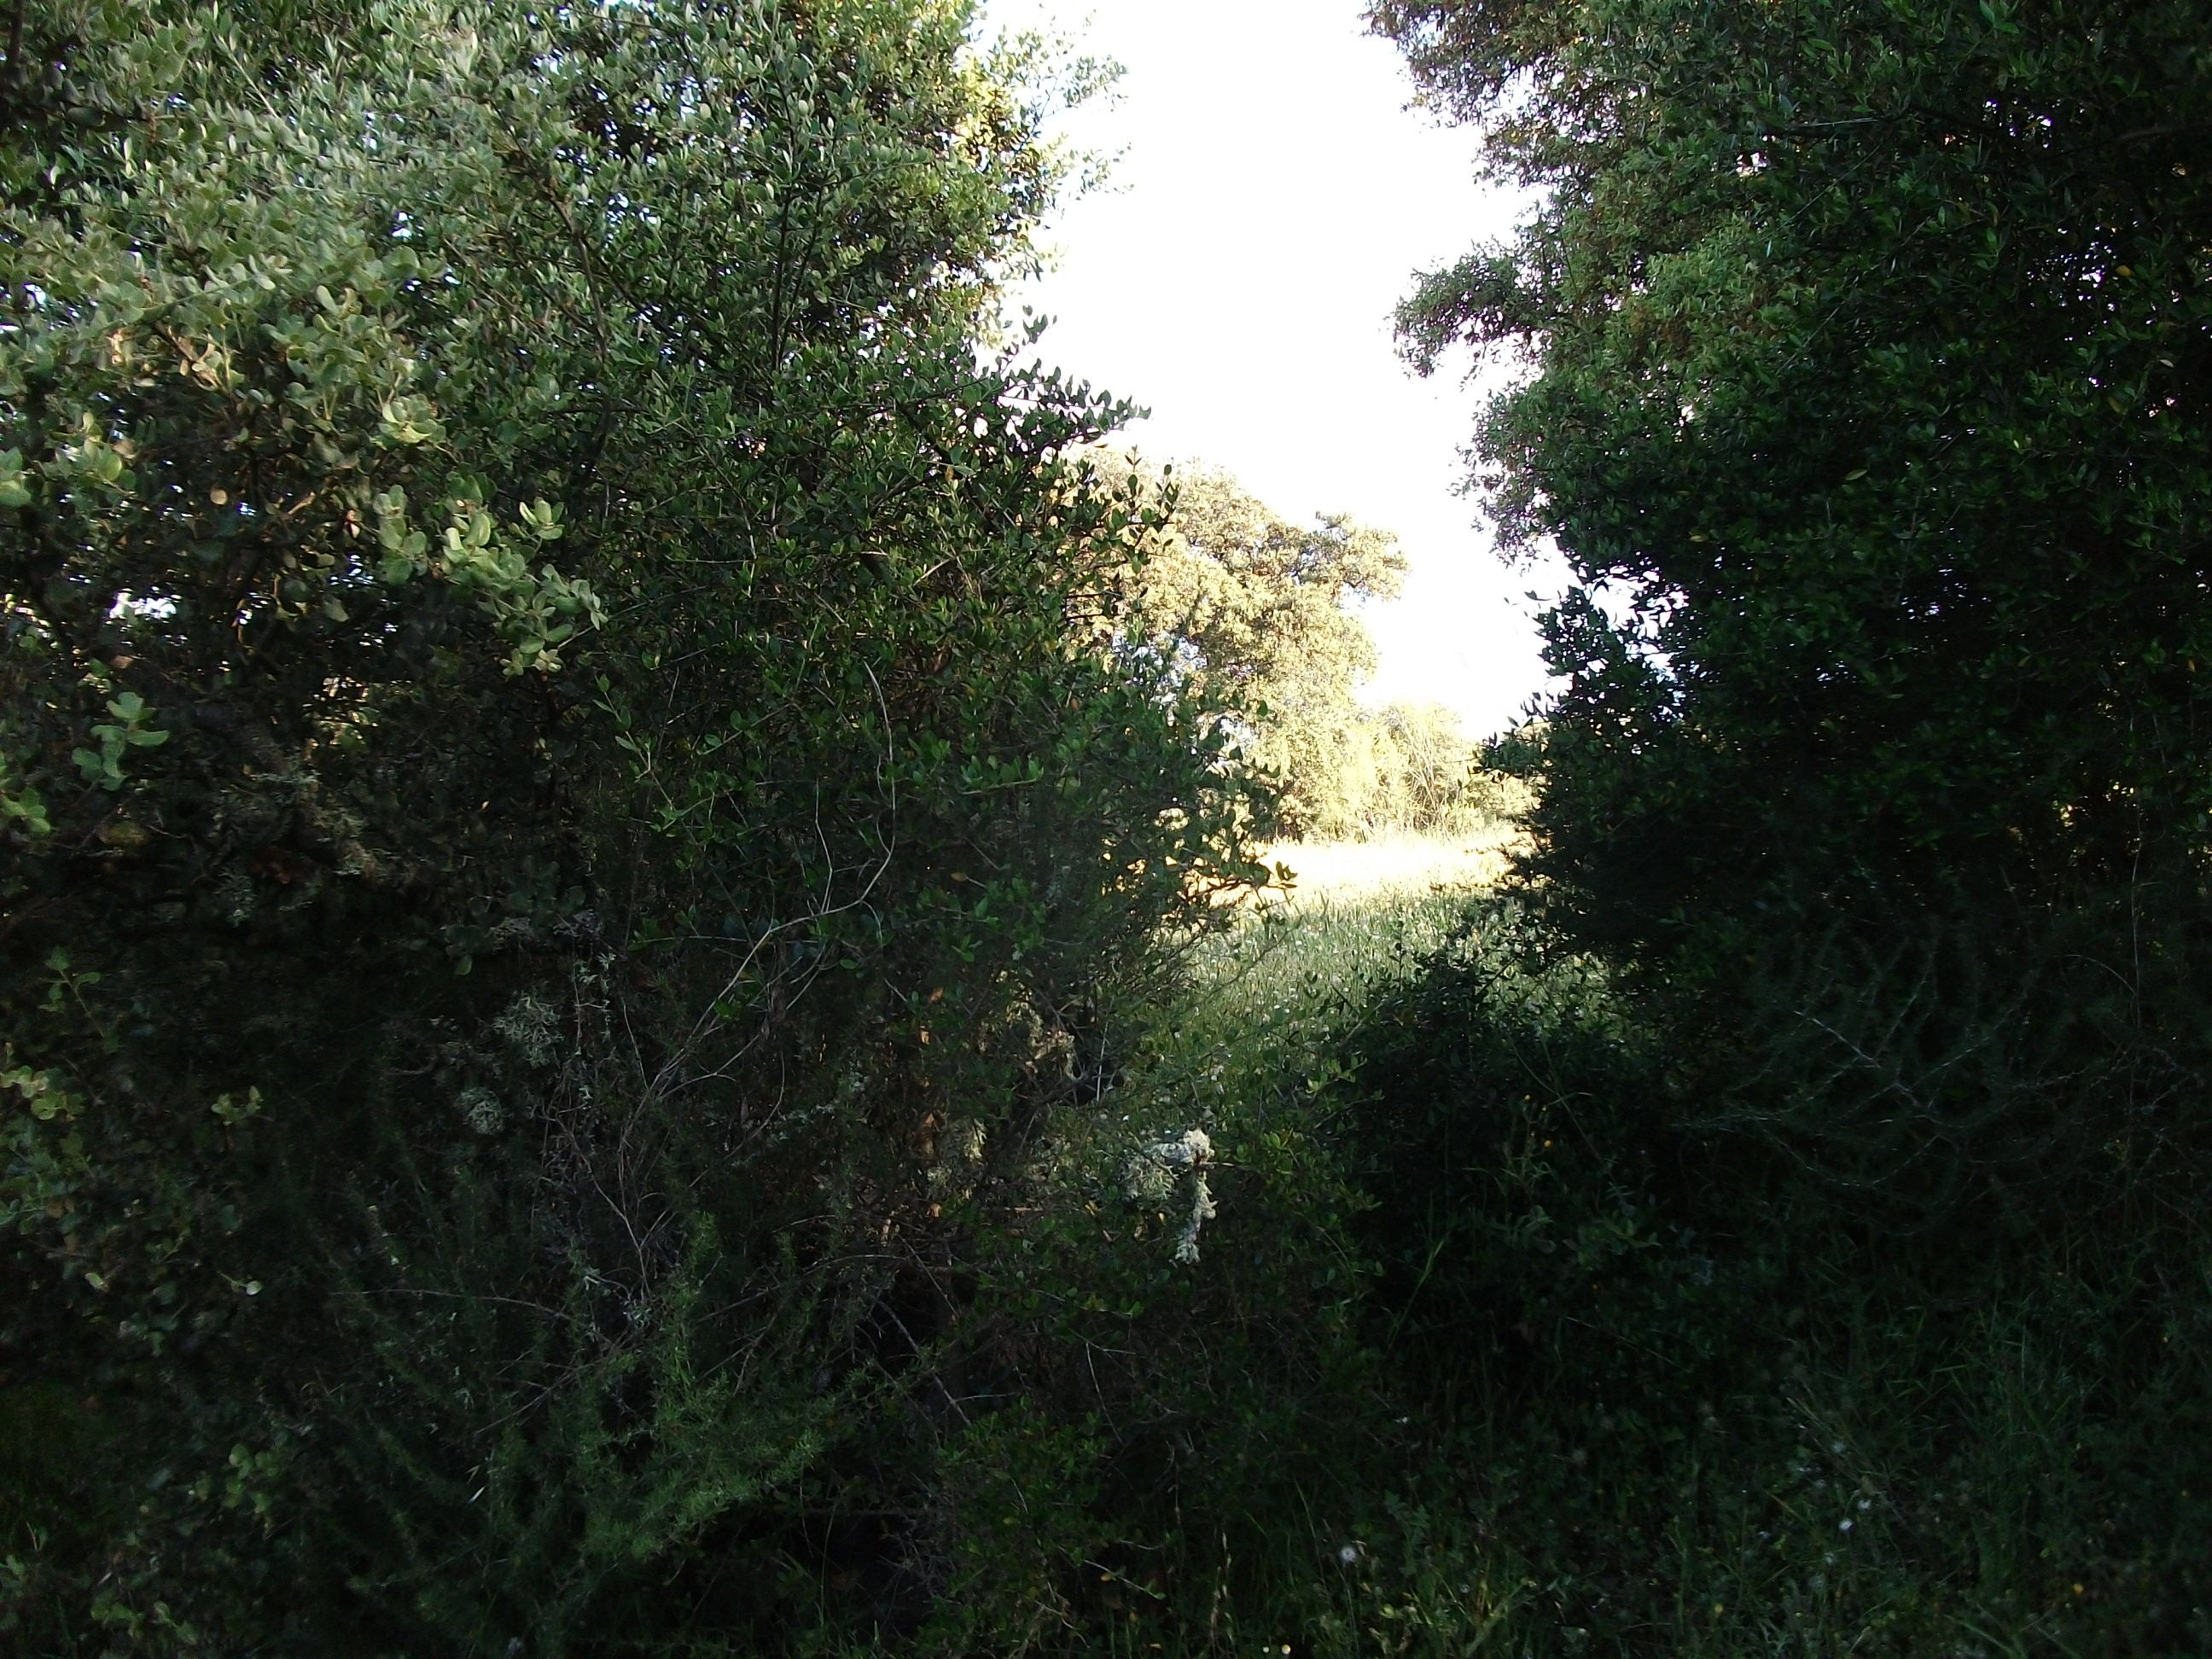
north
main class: Woodland
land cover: Broadleaved woodland
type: broadleaved evergreen forest
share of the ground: 25 - 50 %
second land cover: Spontaneously vegetated surfaces
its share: 25 - 50 %
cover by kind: broadleaved forest trees 40 %, shrubs 30 %, herbaceous plants 30 %
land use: Forestry
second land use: Agriculture (excluding fallow land and kitchen gardens)
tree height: > 5 m
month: April
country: ES
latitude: 38.0425
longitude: -6.7427
